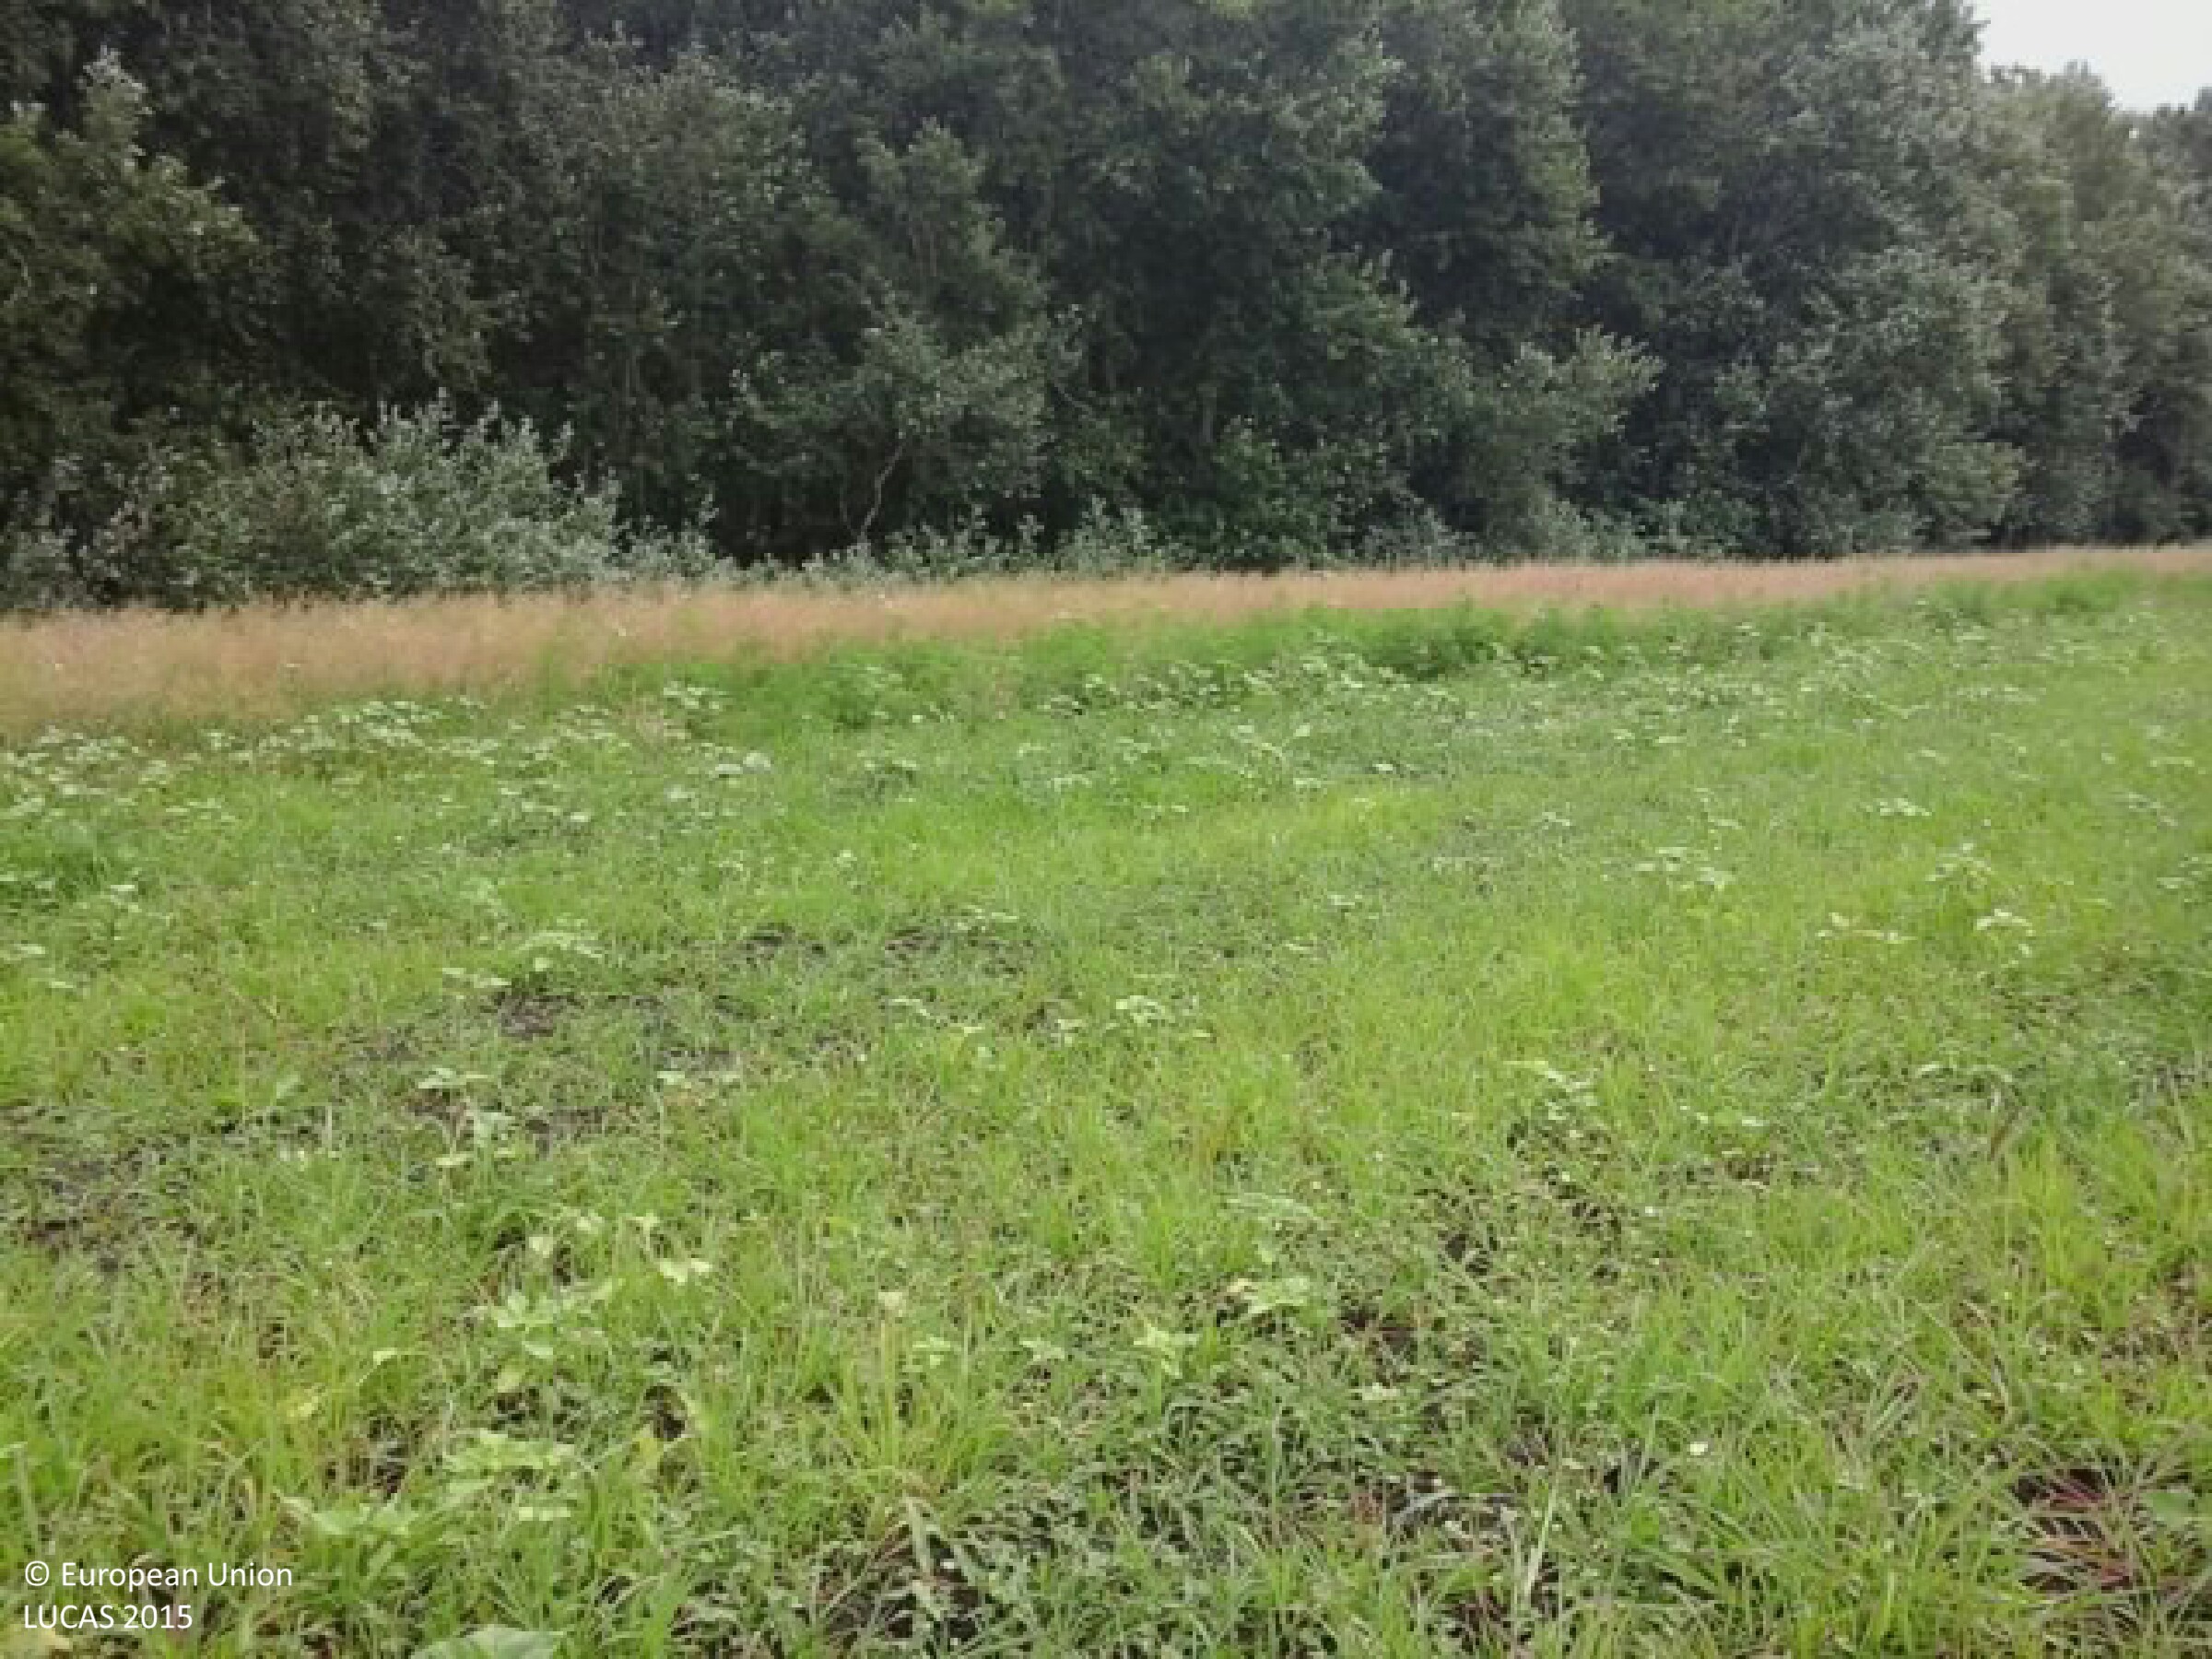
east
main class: Grassland
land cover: Spontaneously vegetated surfaces
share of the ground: > 75 %
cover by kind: herbaceous plants 100 %
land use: Fallow land
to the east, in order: Spontaneously vegetated surfaces; Grass margins; Broadleaved woodland
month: June
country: HU
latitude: 46.5584
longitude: 20.1325
